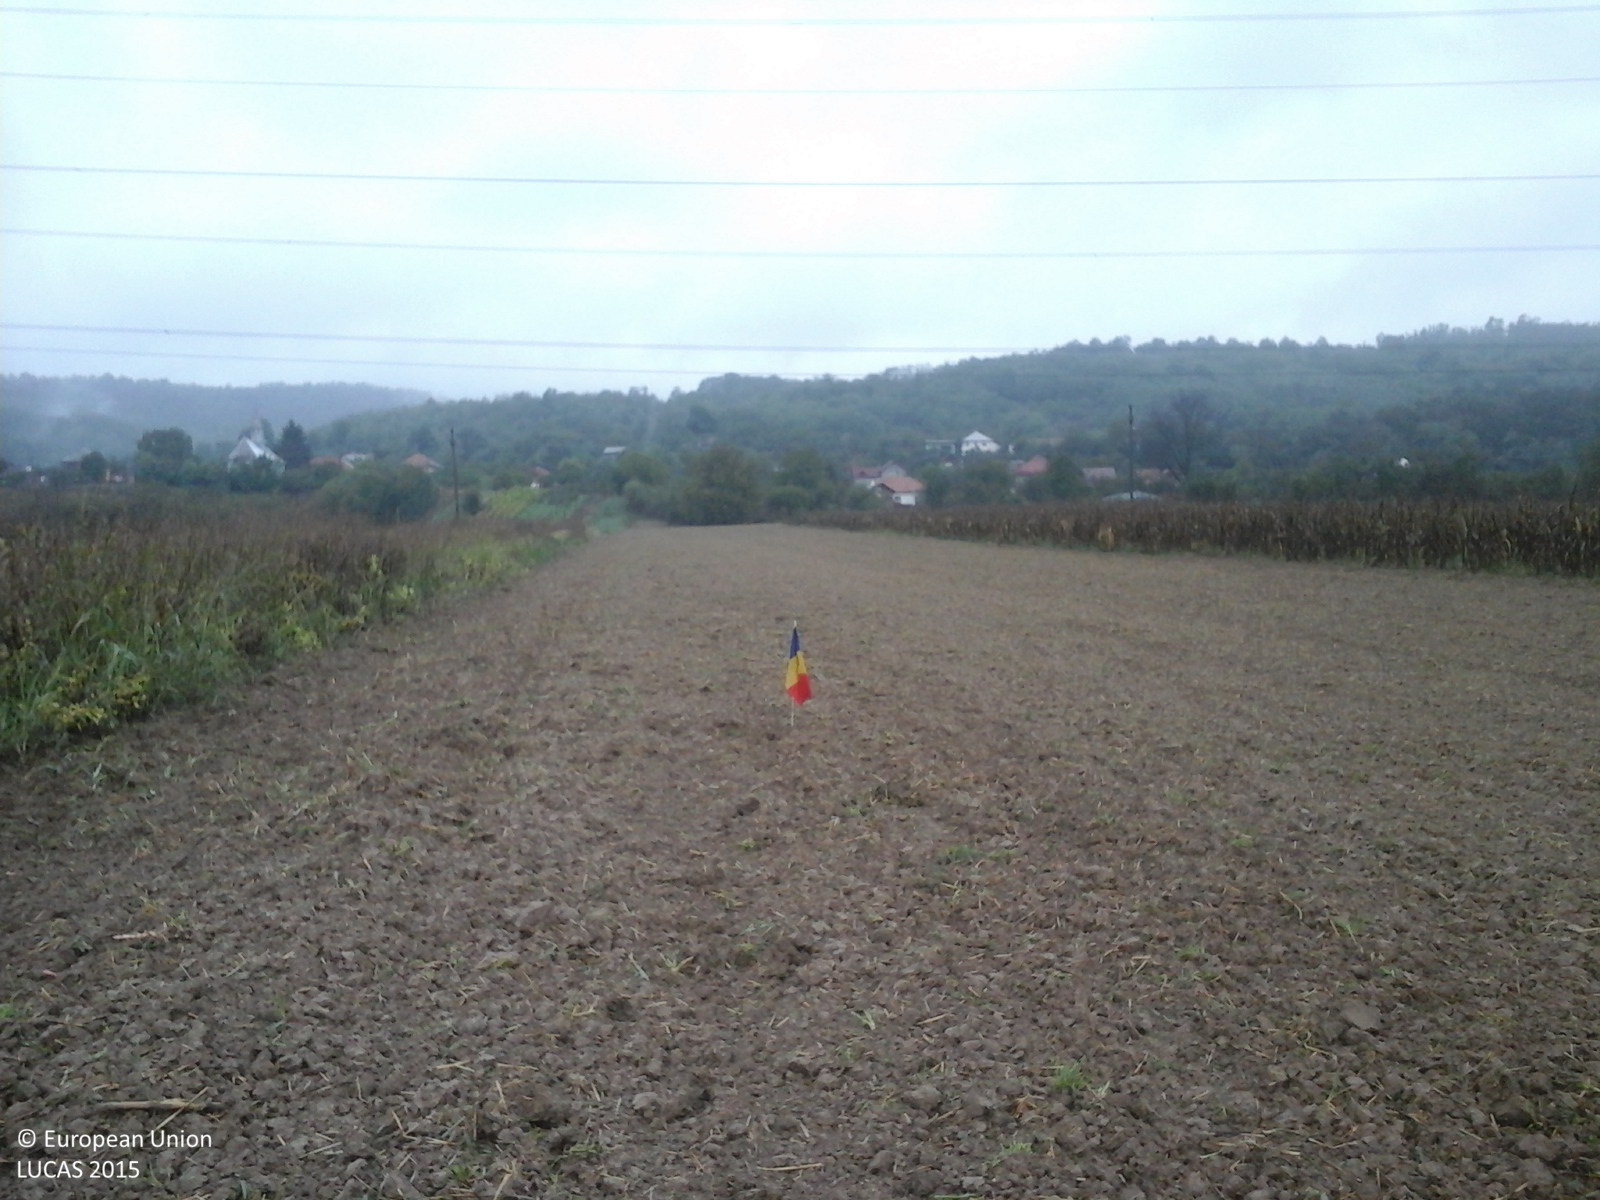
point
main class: Cropland
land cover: Common wheat
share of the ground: < 10 %
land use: Agriculture (excluding fallow land and kitchen gardens)
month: September
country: RO
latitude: 44.8686
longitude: 23.5108
